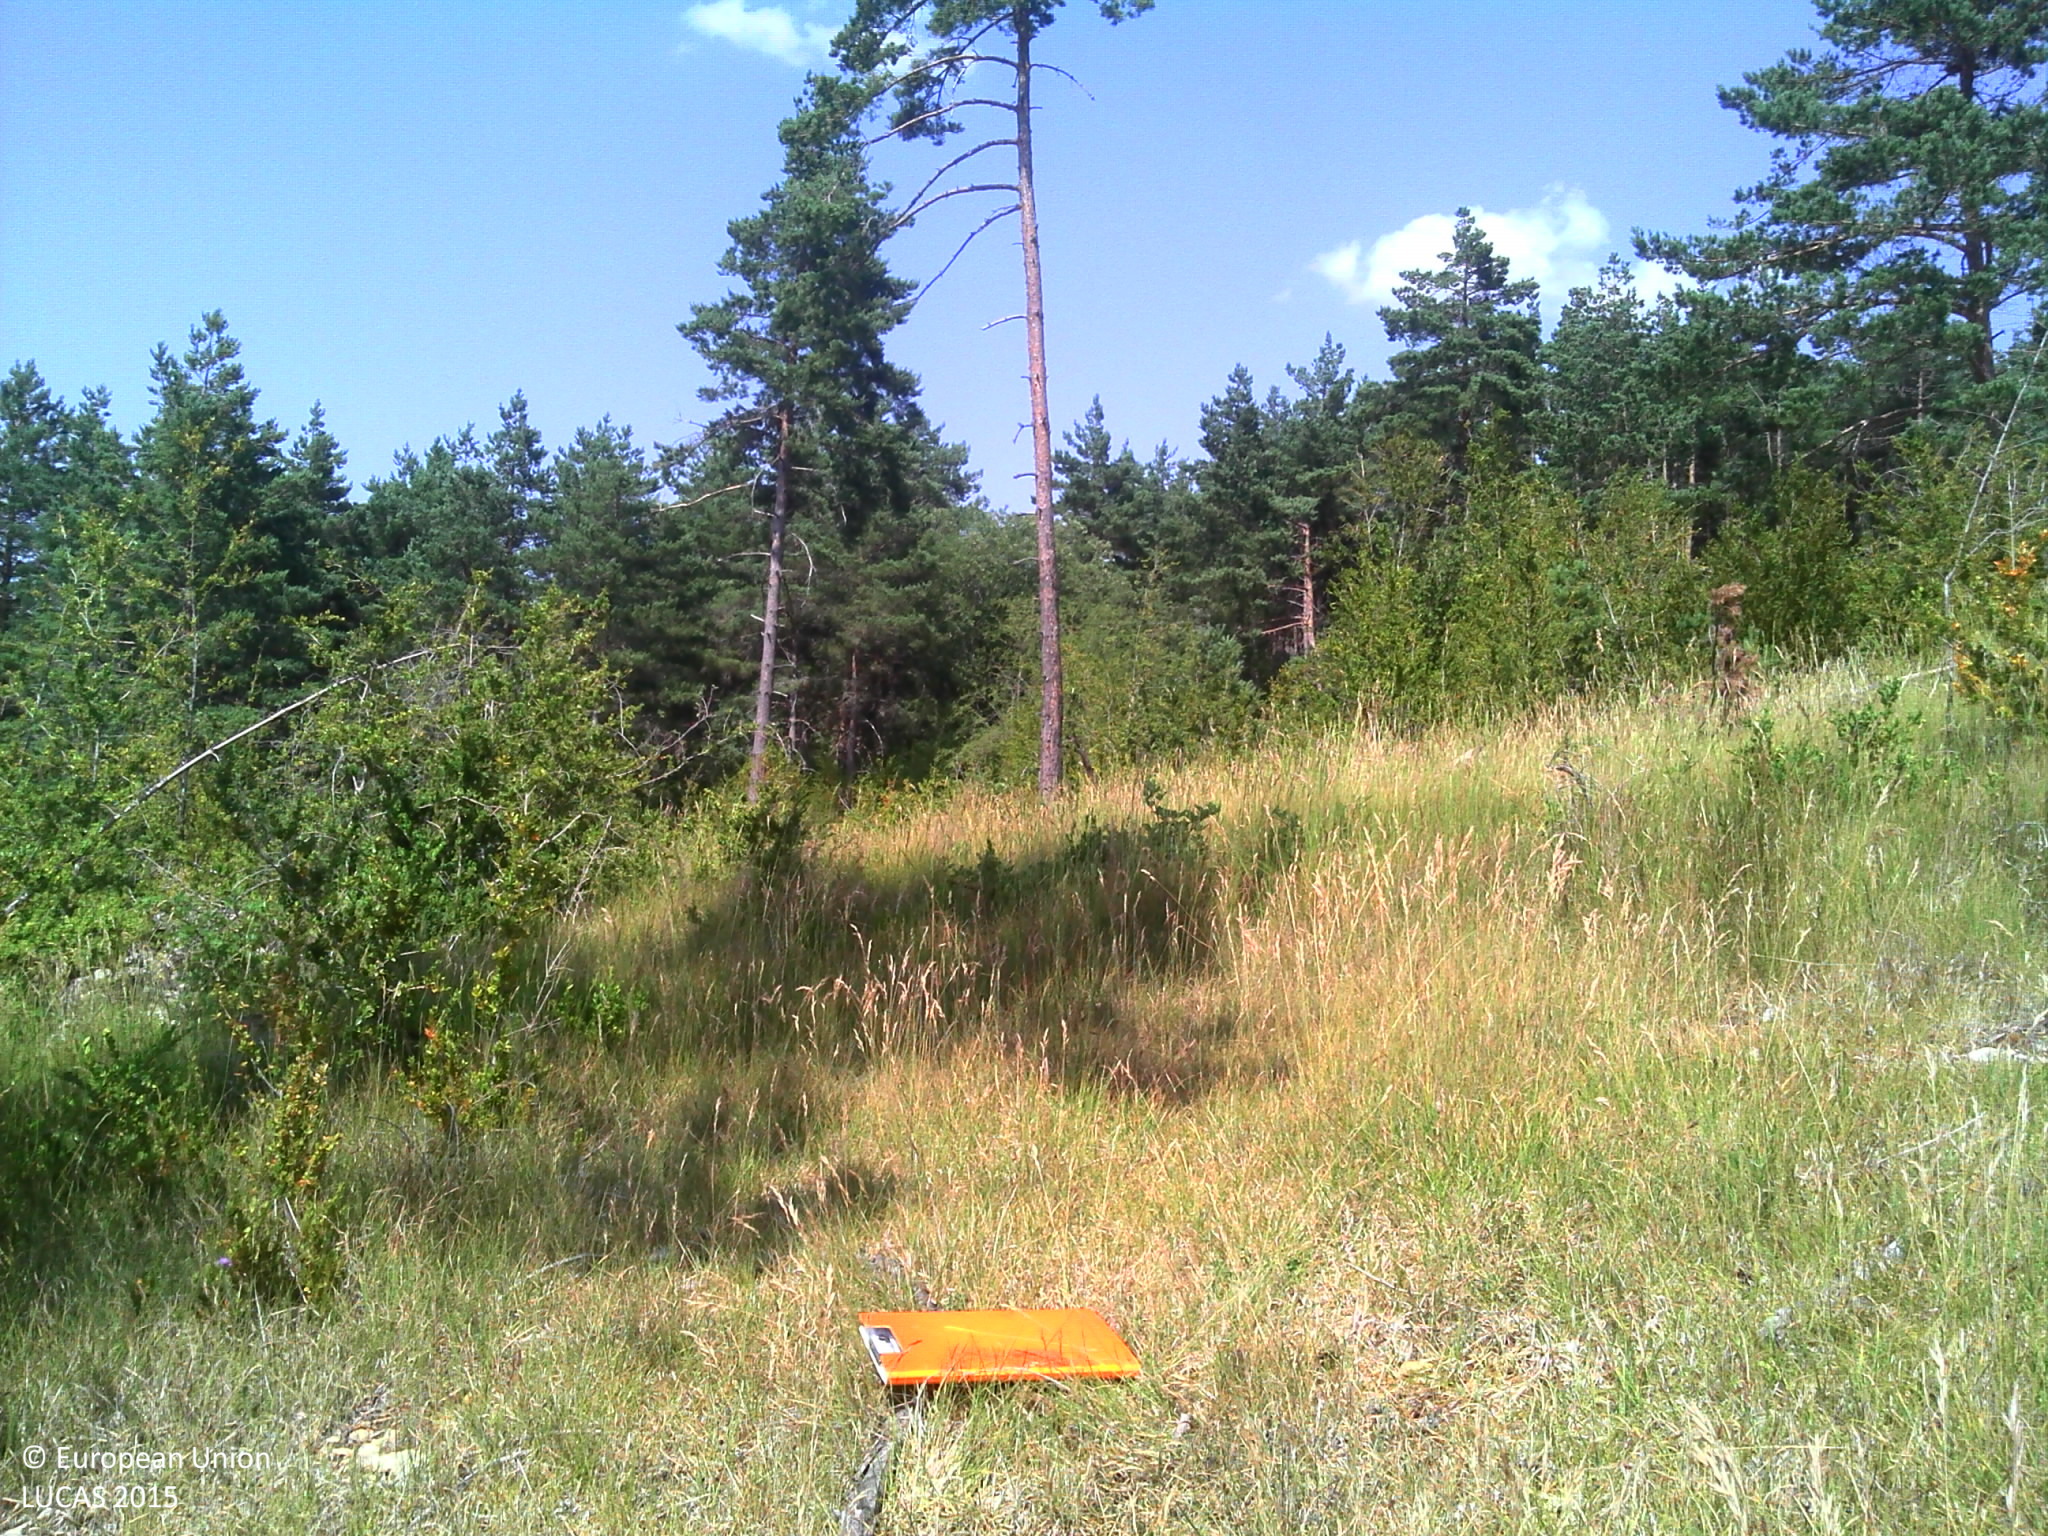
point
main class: Shrubland
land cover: Shrubland with sparse tree cover
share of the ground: > 75 %
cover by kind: shrubs 95 %, coniferous forest trees 5 %
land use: Forestry
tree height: < 5 m
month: July
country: FR
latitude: 44.2413
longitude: 3.2816
